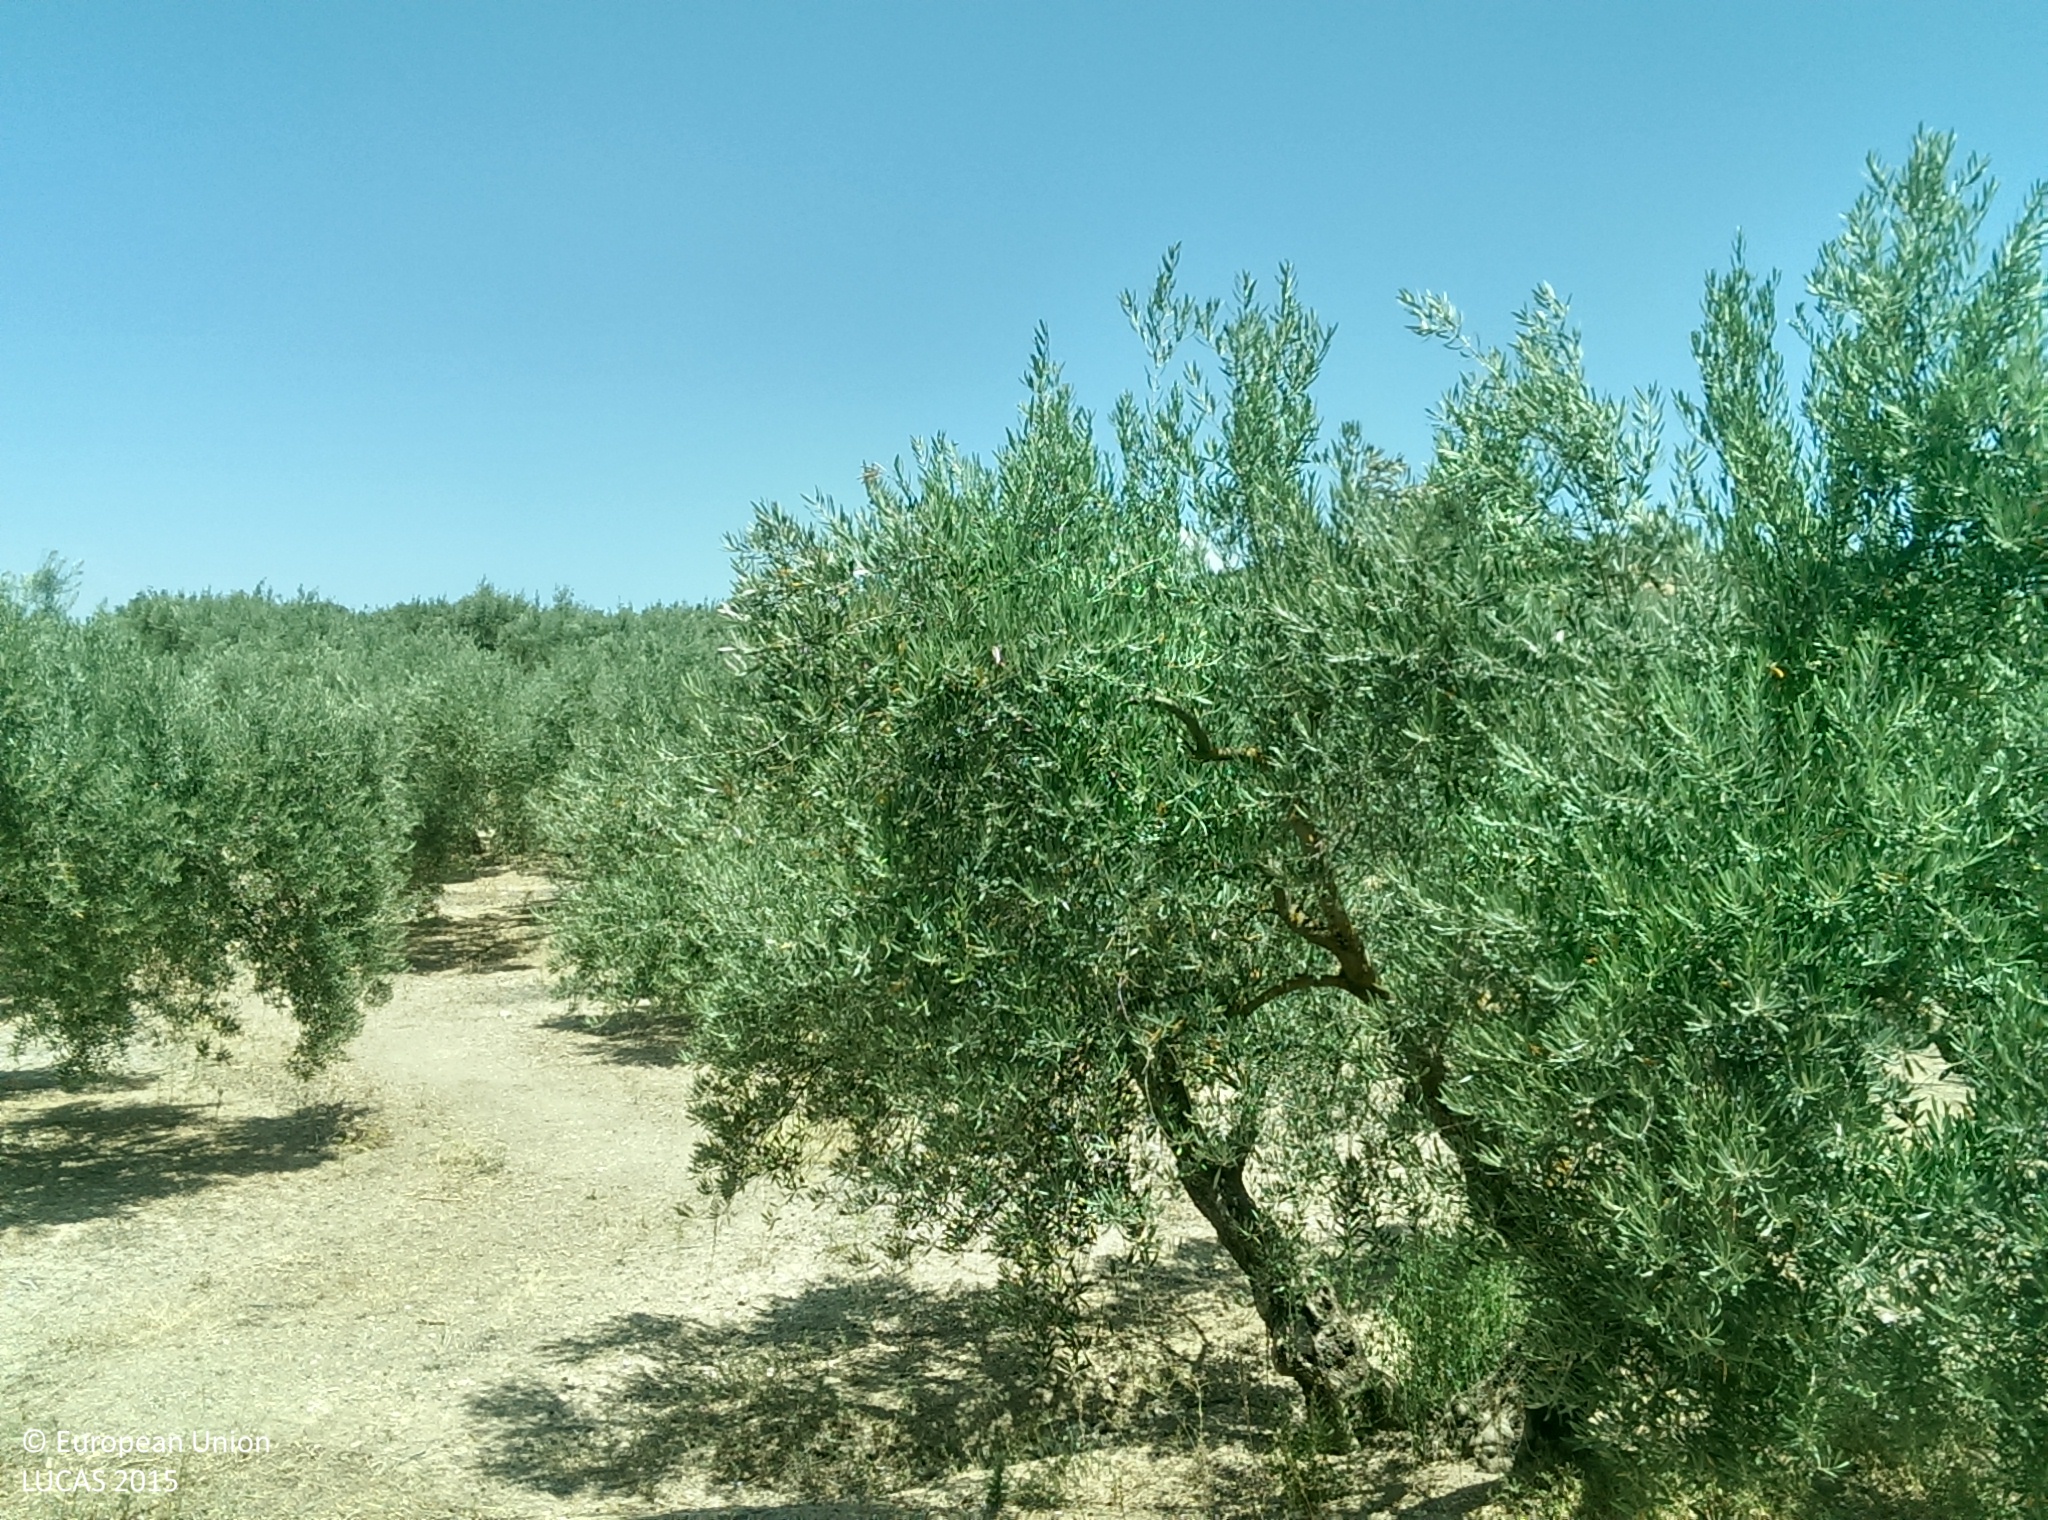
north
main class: Cropland
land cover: Olive groves
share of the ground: 50 - 75 %
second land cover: Spontaneously vegetated surfaces
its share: 10 - 25 %
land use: Agriculture (excluding fallow land and kitchen gardens)
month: July
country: ES
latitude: 37.4090
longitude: -3.7210
